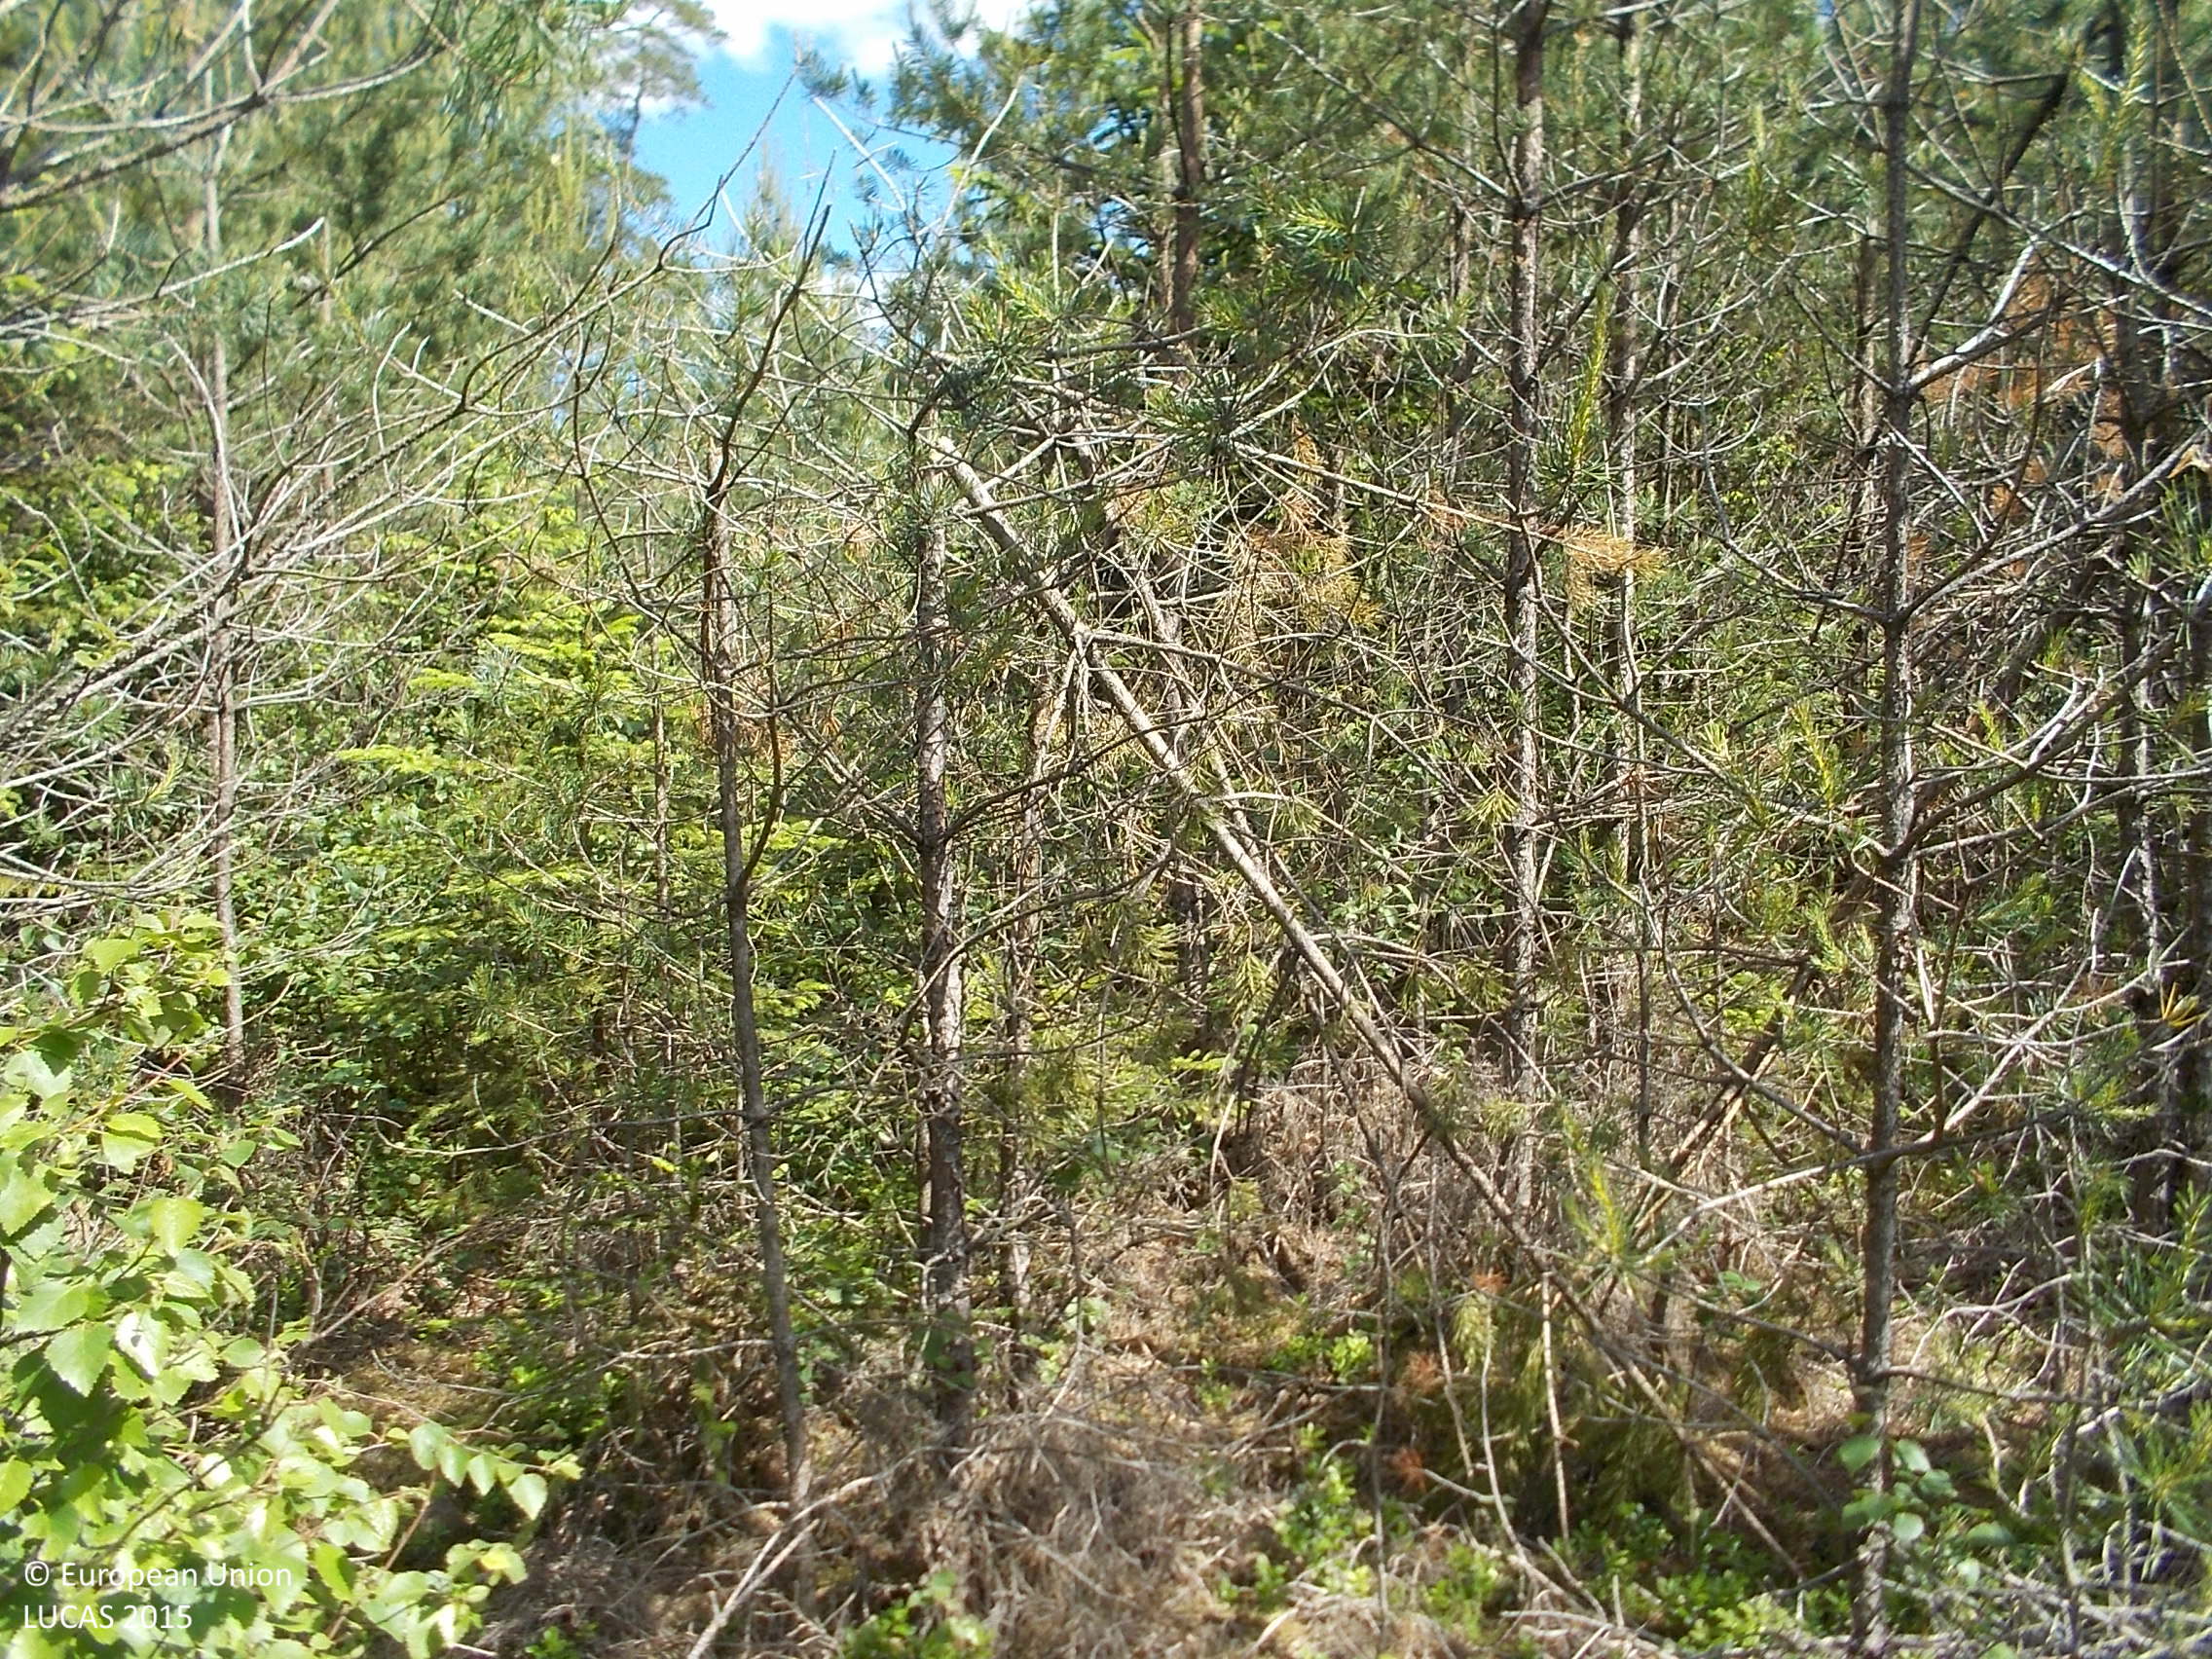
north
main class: Woodland
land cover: Pine dominated coniferous woodland
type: boreal forest
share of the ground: 50 - 75 %
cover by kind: coniferous forest trees 70 %, shrubs 25 %, broadleaved forest trees 5 %
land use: Forestry
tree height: < 5 m
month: June
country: SE
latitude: 57.7501
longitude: 12.2981
